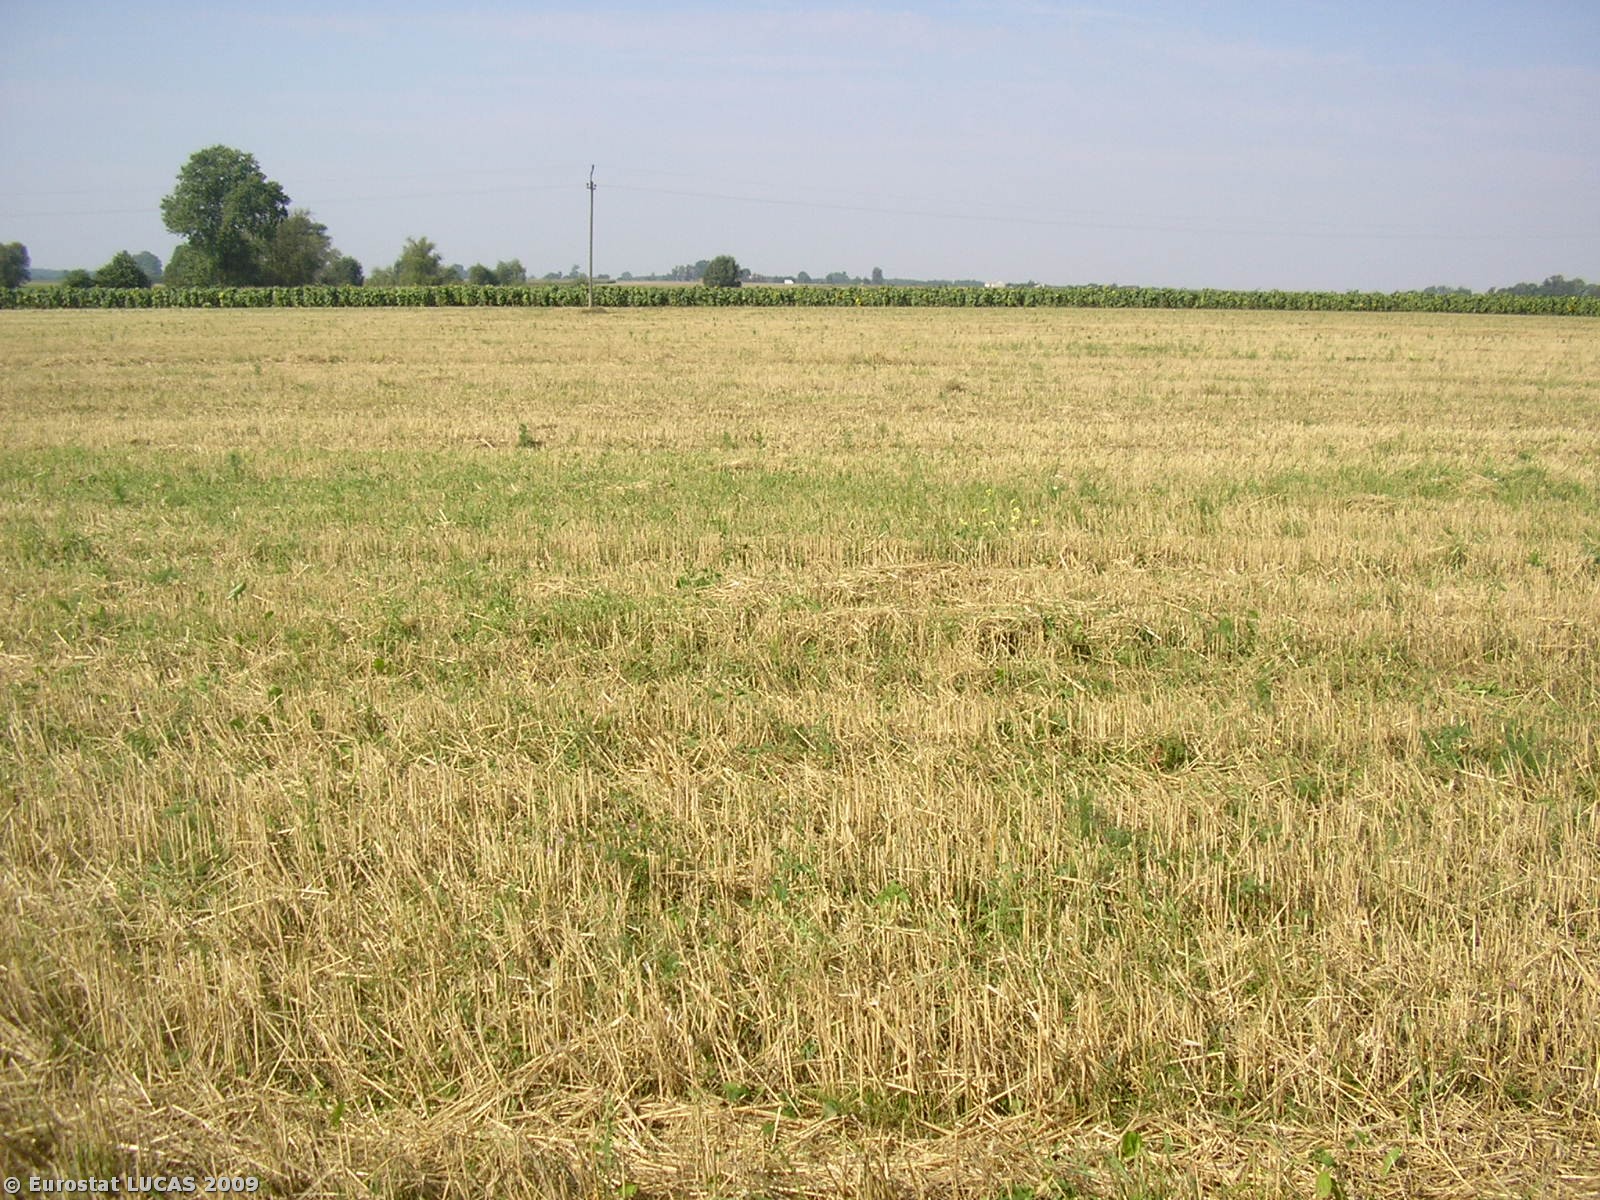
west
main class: Cropland
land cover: Rye
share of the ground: < 10 %
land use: Agriculture (excluding fallow land and kitchen gardens)
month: September
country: PL
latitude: 52.1219
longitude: 19.5068
